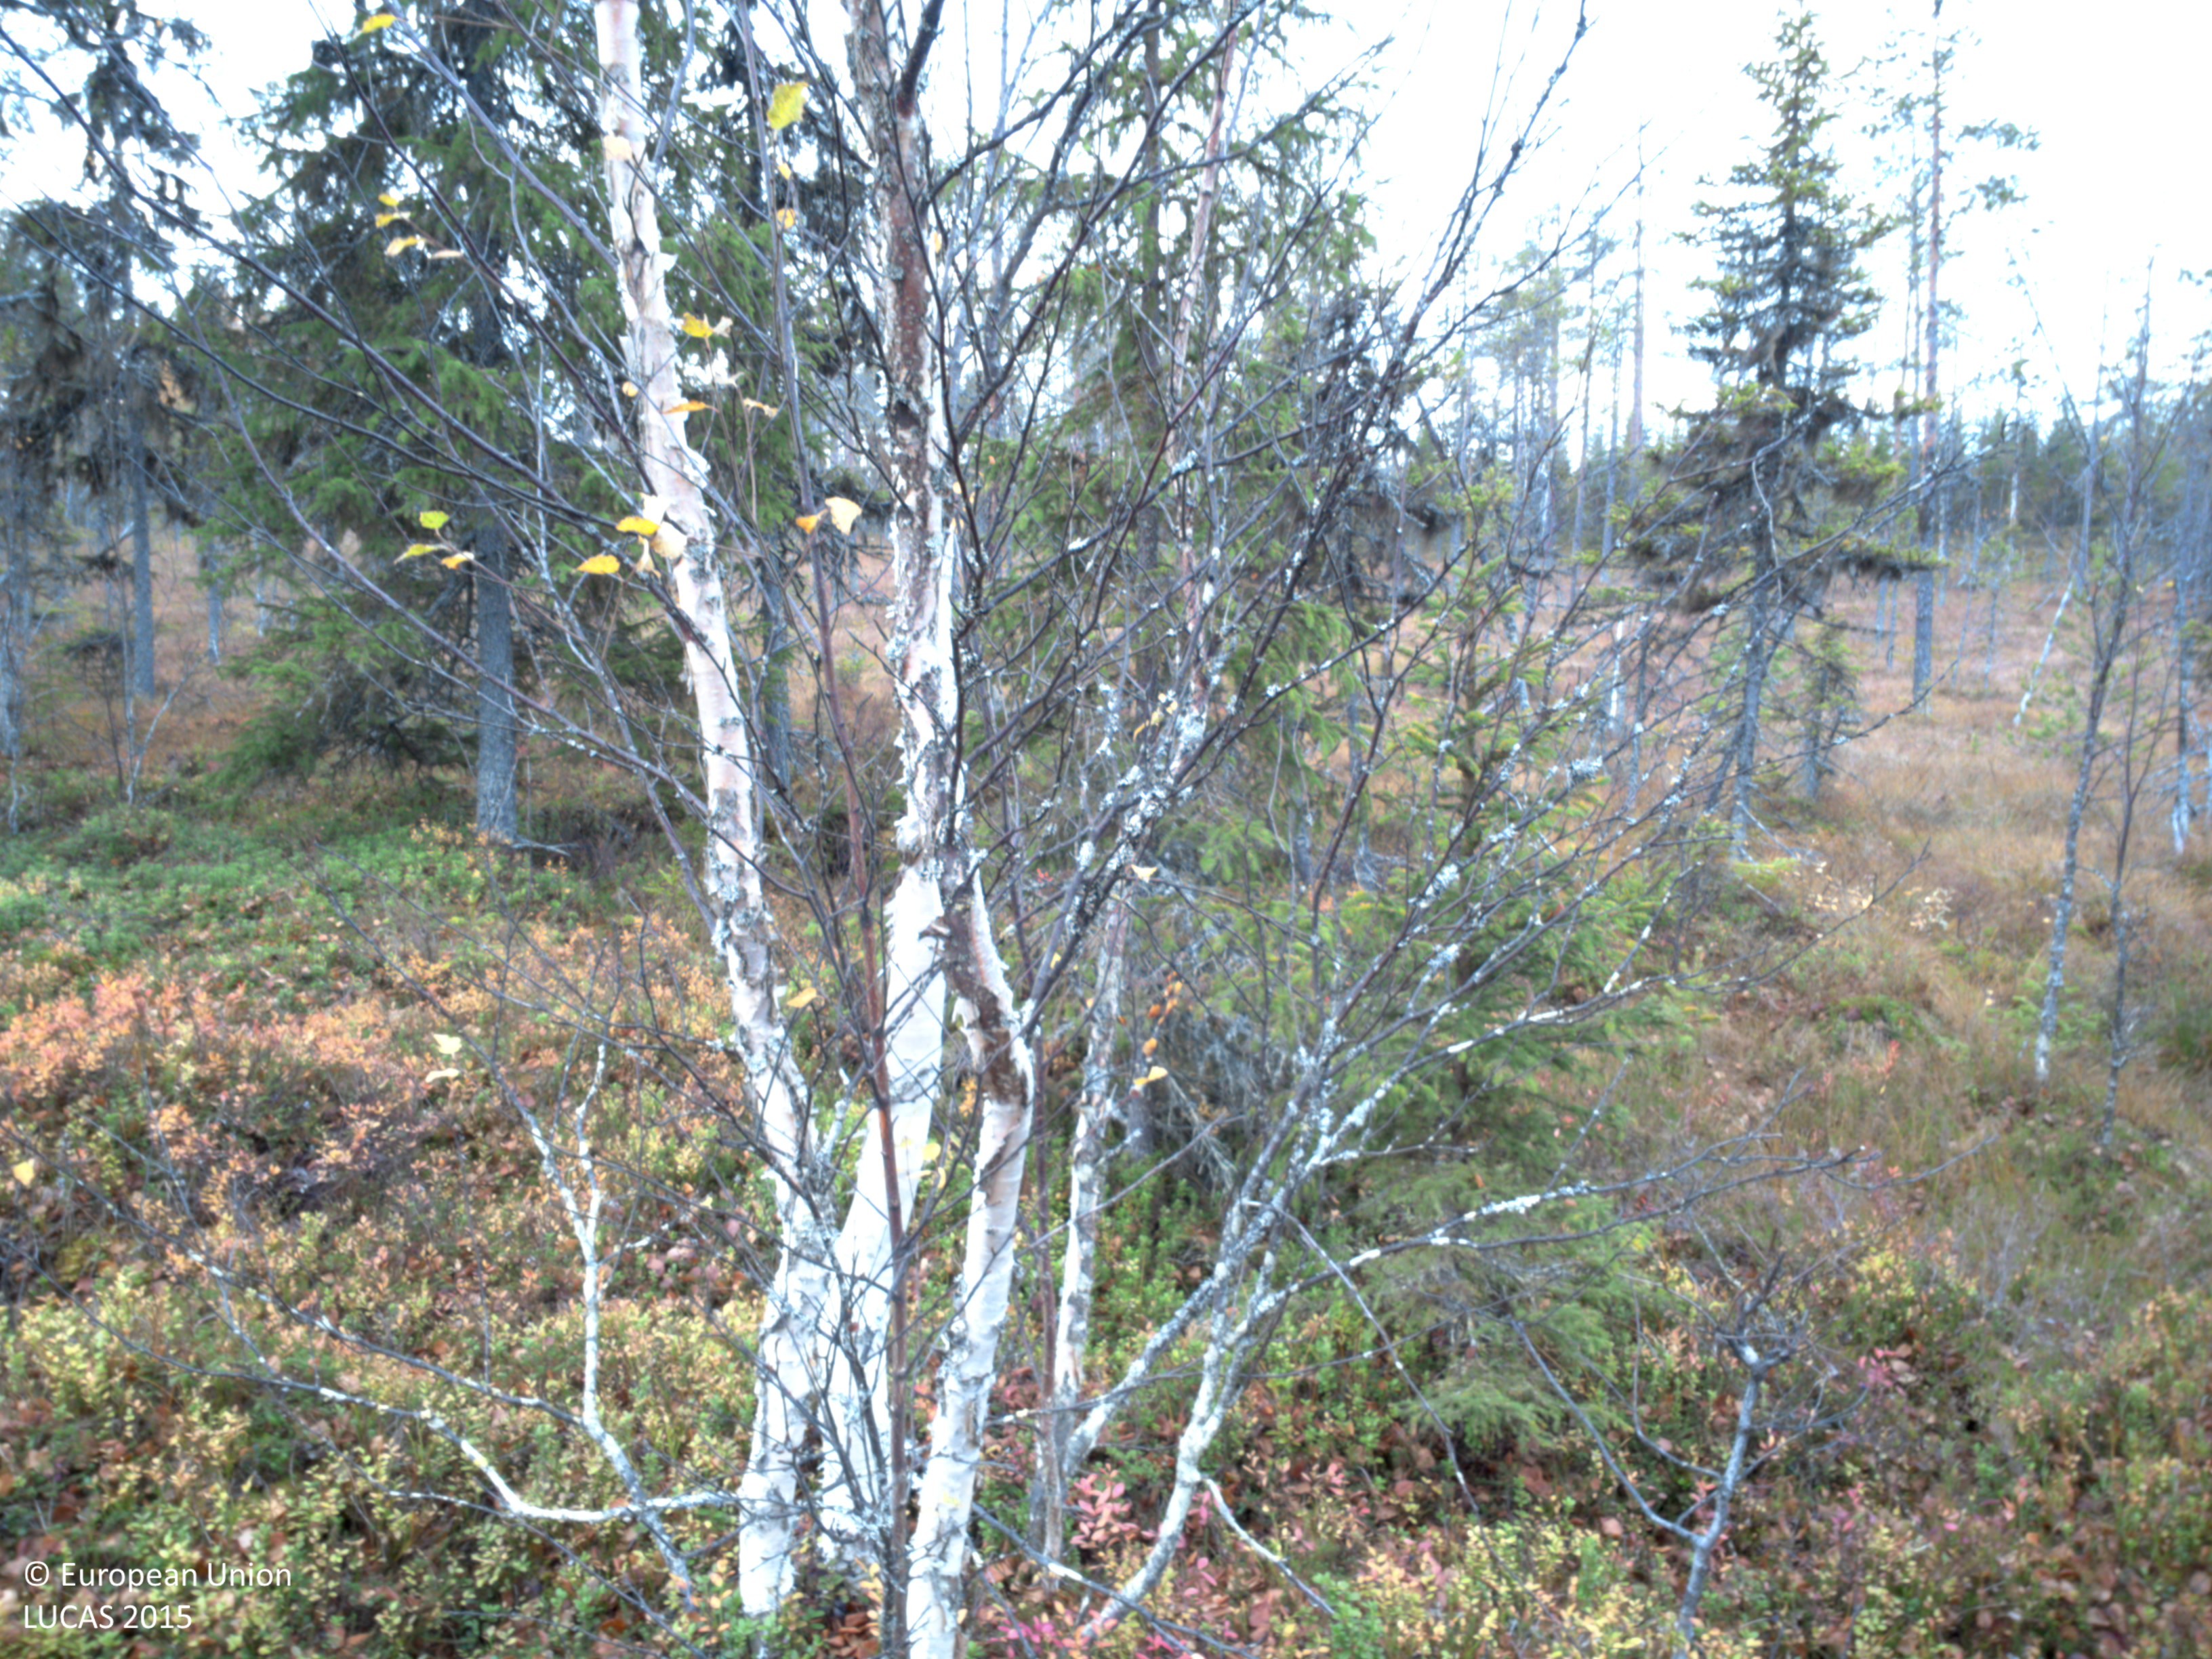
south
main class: Woodland
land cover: Spruce dominated mixed woodland
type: boreal forest
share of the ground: 25 - 50 %
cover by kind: shrubs 50 %, coniferous forest trees 30 %, broadleaved forest trees 10 %, herbaceous plants 5 %, lichens and mosses 5 %
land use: Forestry
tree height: < 5 m
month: October
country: SE
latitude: 64.6945
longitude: 18.2066
